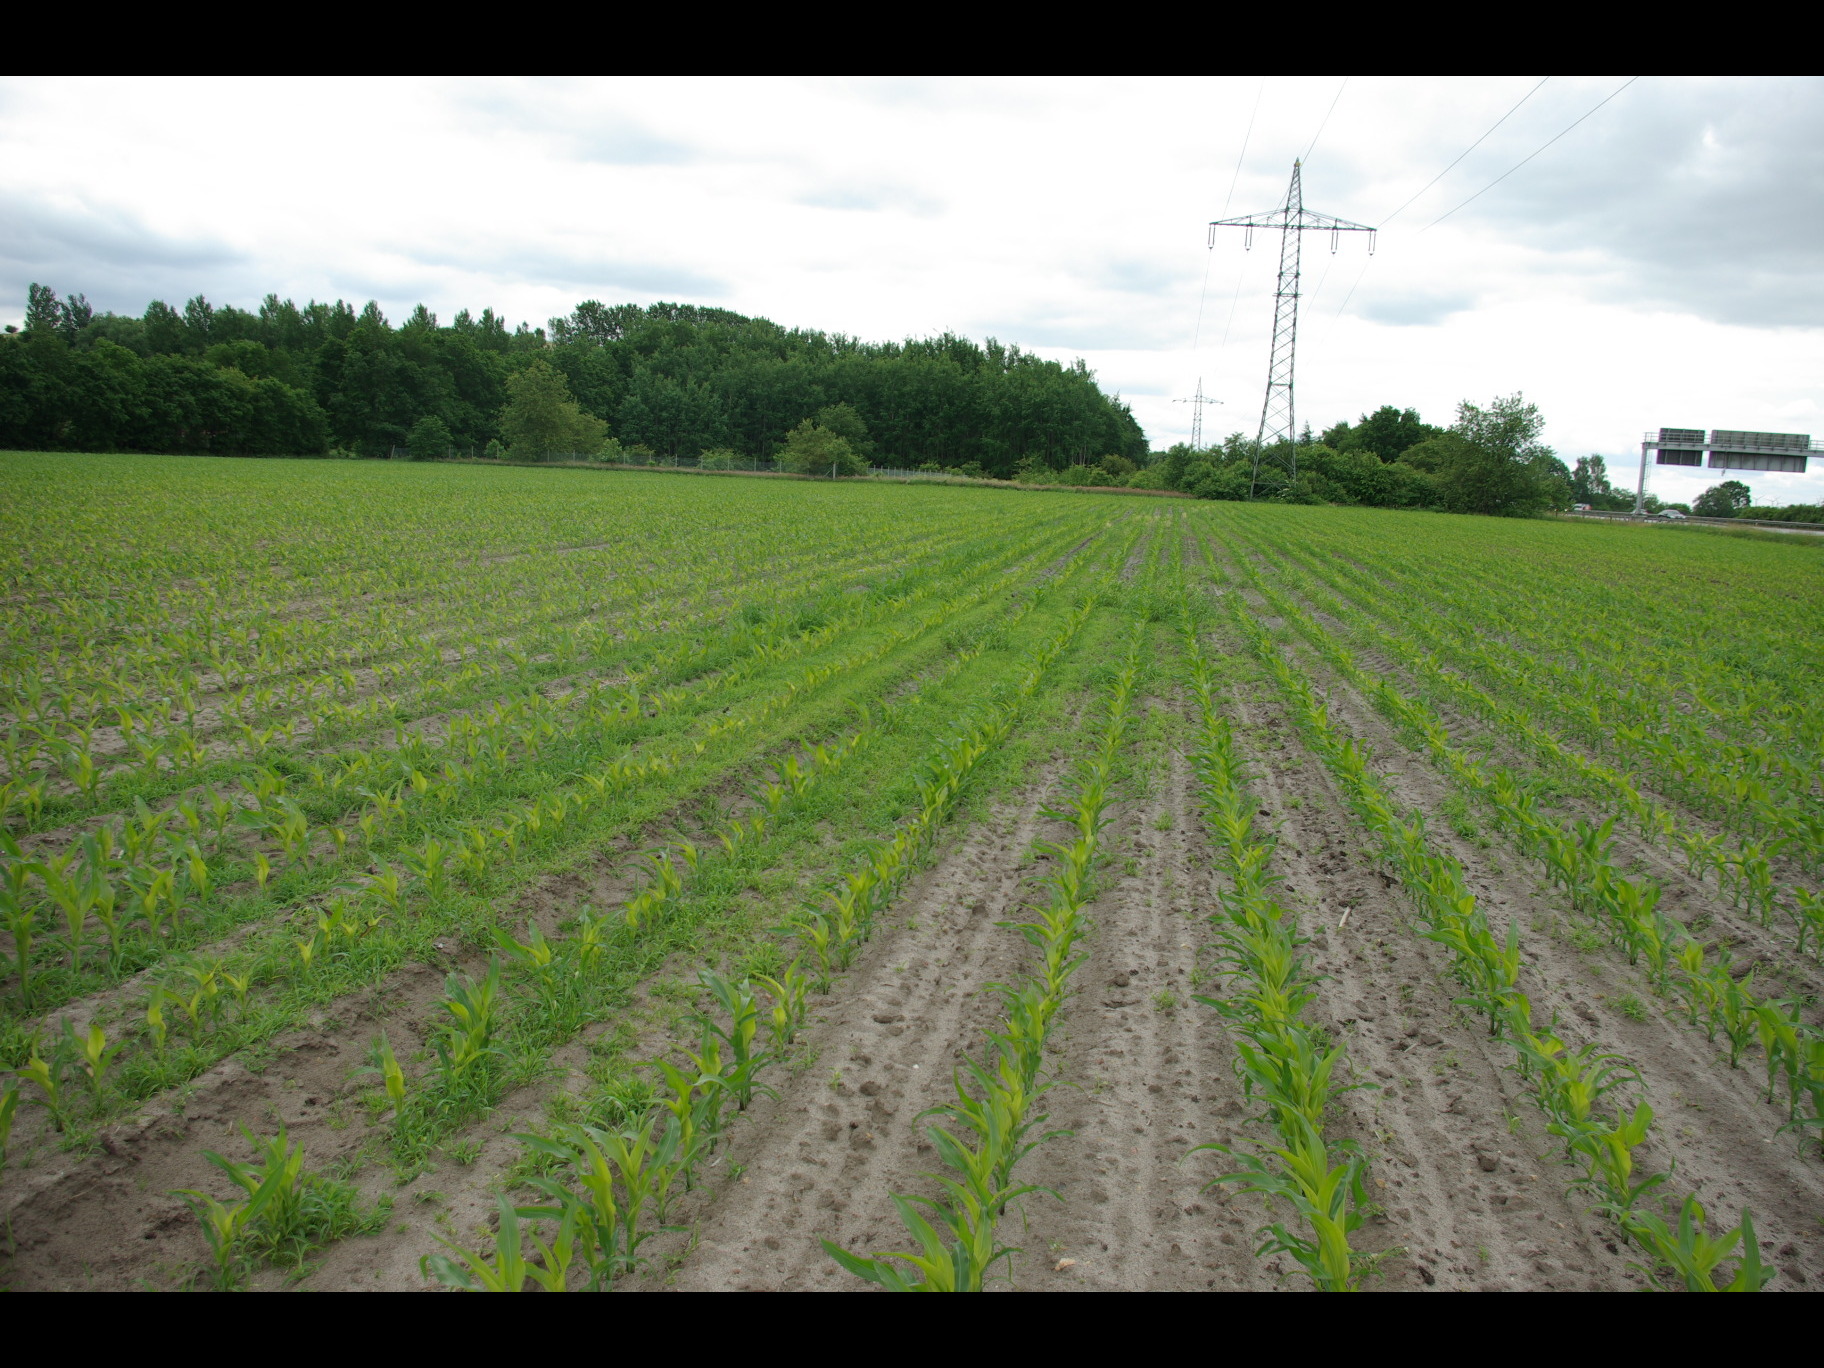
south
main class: Cropland
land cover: Maize
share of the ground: 25 - 50 %
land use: Agriculture (excluding fallow land and kitchen gardens)
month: June
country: DE
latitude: 54.0669
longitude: 9.9236
